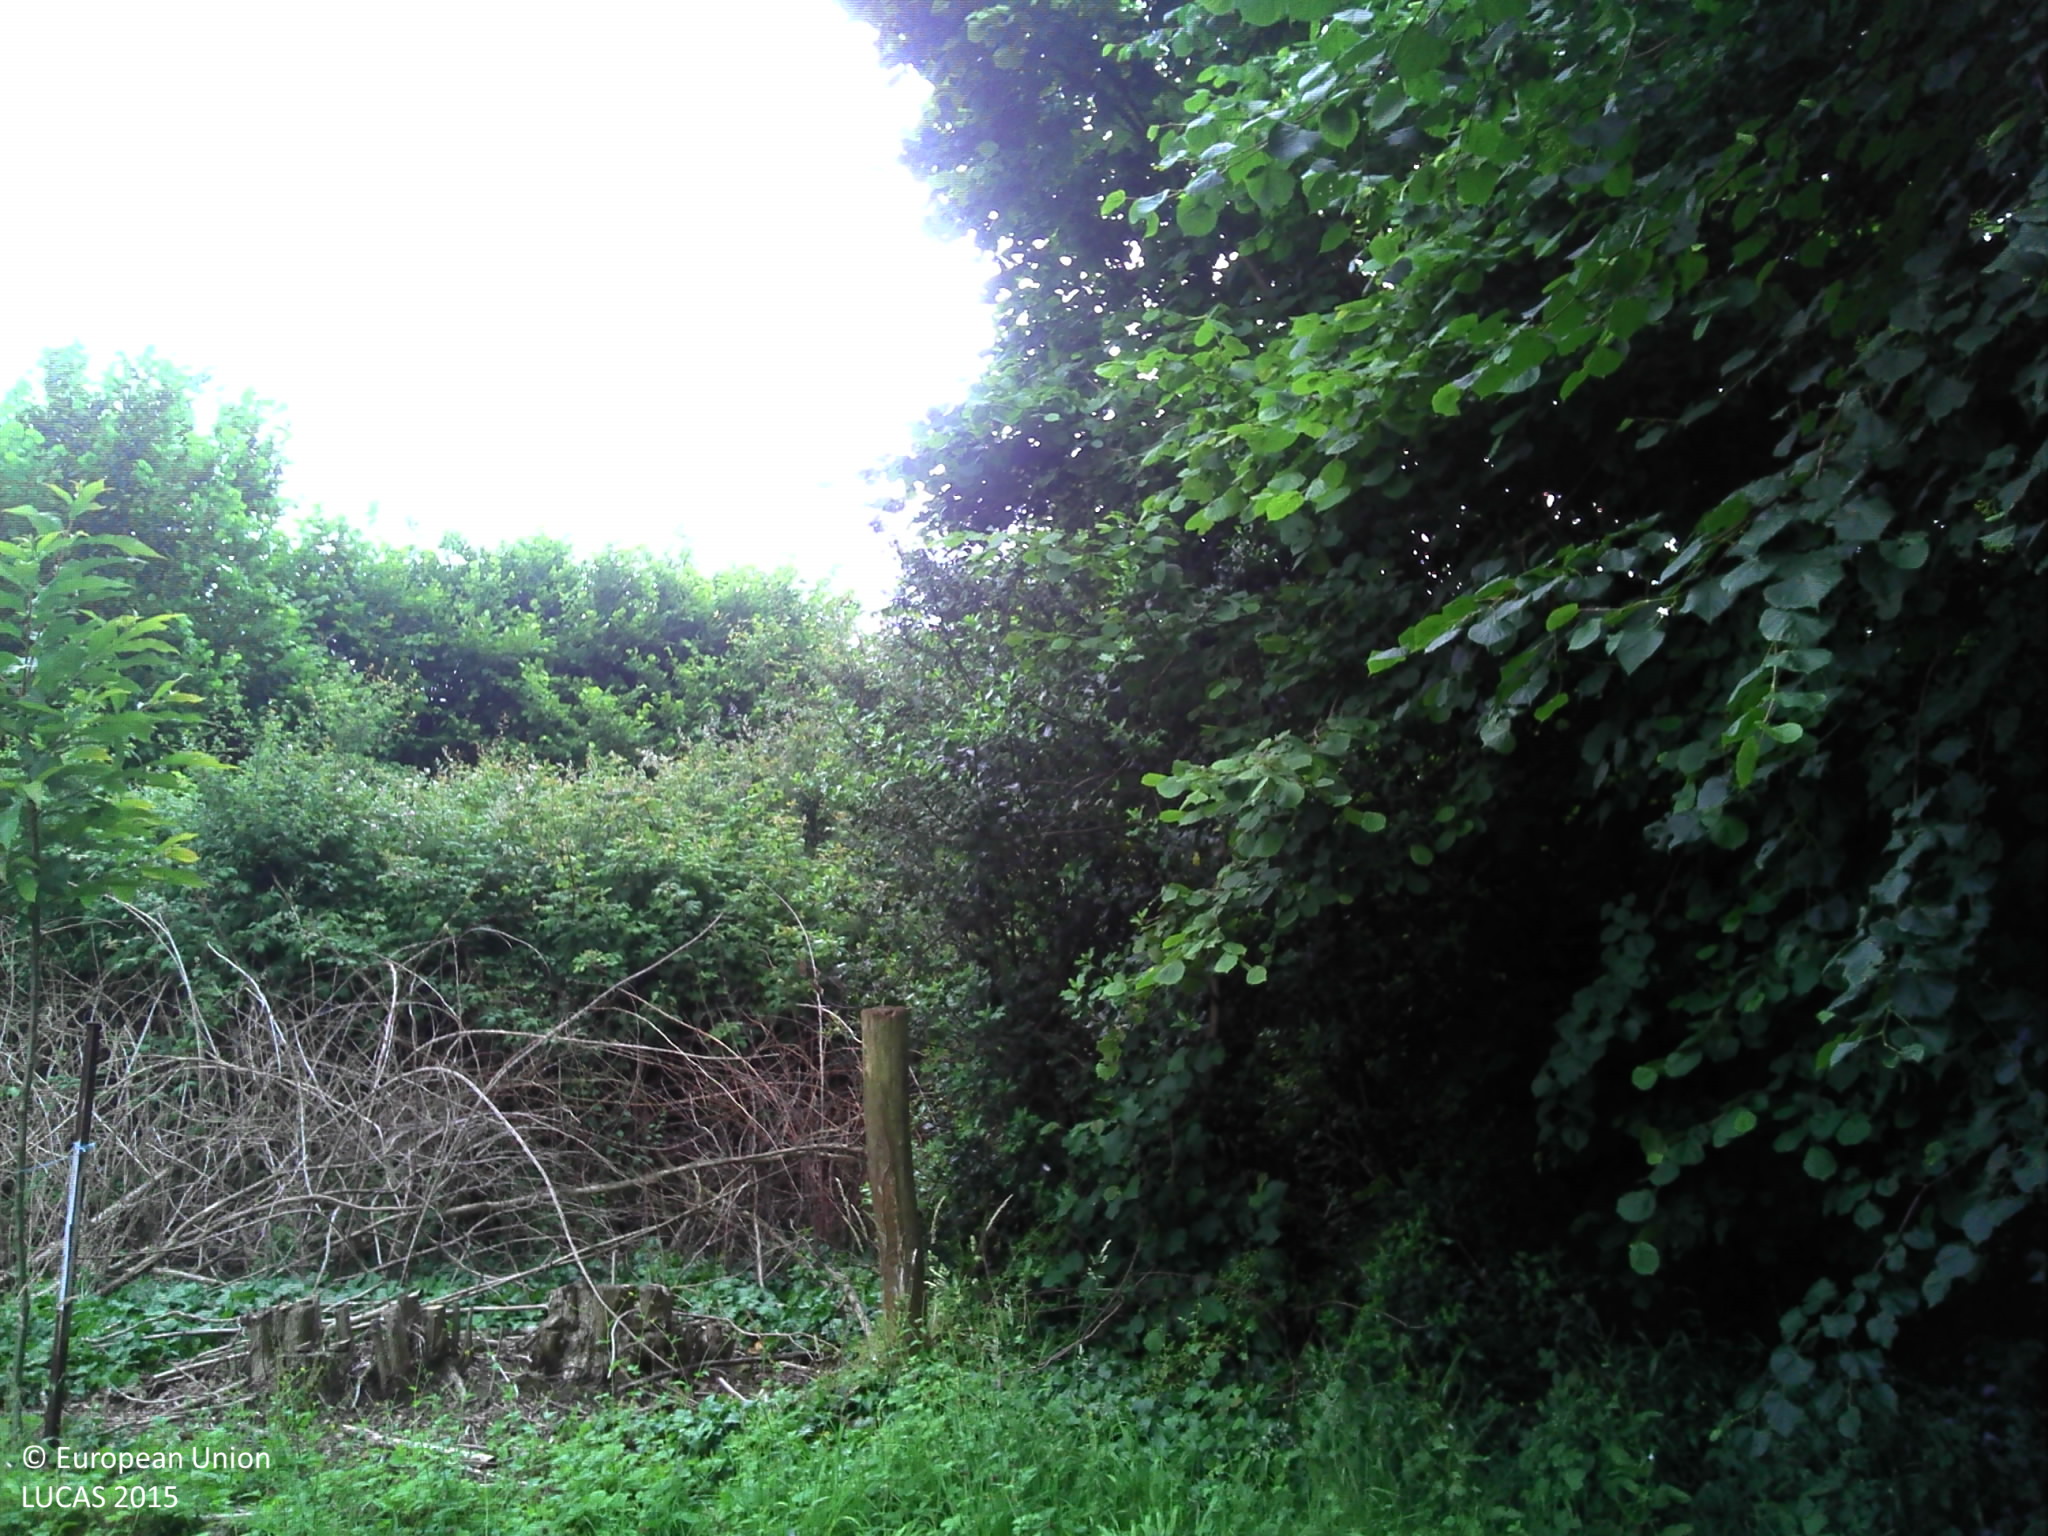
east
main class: Grassland
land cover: Grassland with sparse tree/shrub cover
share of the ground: > 75 %
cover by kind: herbaceous plants 95 %, broadleaved forest trees 5 %
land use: Agriculture (excluding fallow land and kitchen gardens)
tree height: > 5 m
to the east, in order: Grassland with sparse tree/shrub cover; Abandoned hedges; Grassland with sparse tree/shrub cover; Abandoned hedges; Barley; Ditches and canals; Electric lines; Grass margins; Paved roads, cycling and walking lanes; Grass margins; Ditches and canals; Fences; Single bushes/trees; Abandoned hedges; Grassland without tree/shrub cover; Electric lines; Grassland without tree/shrub cover
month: June
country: FR
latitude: 48.0417
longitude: 0.2225
